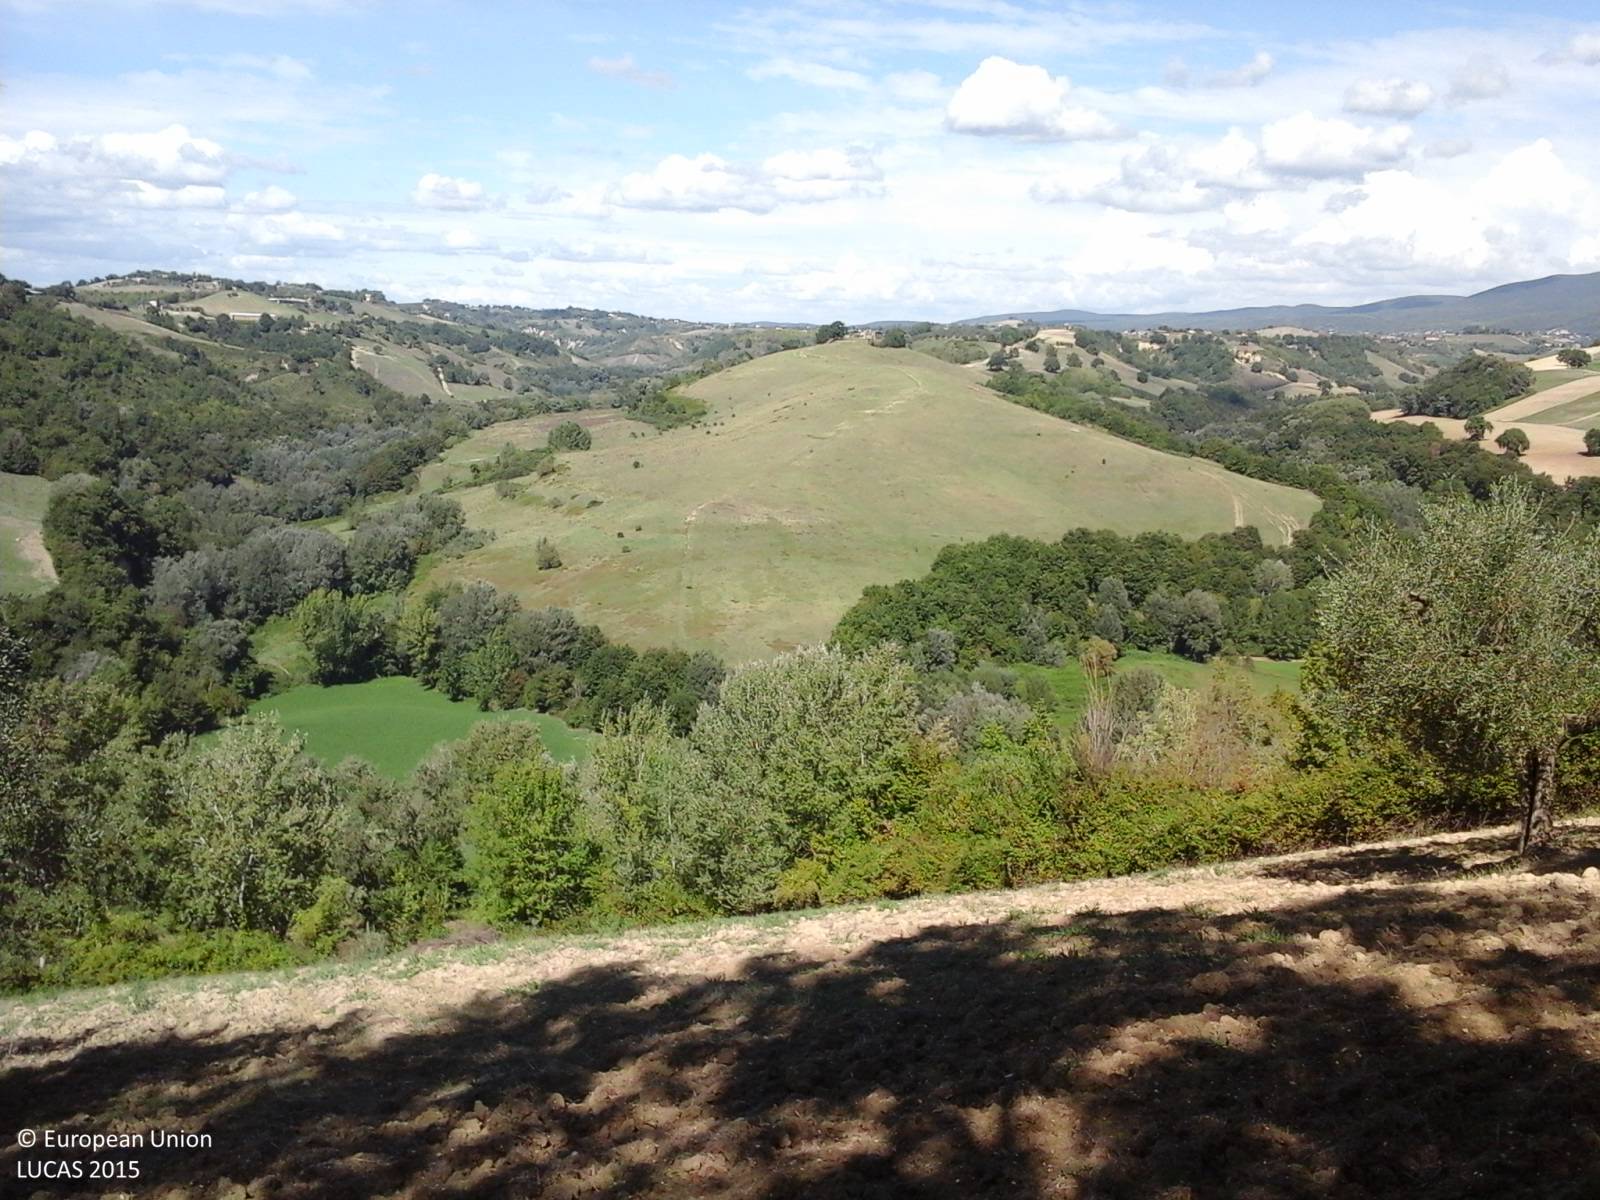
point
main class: Grassland
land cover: Grassland without tree/shrub cover
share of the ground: > 75 %
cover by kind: herbaceous plants 100 %
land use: Agriculture (excluding fallow land and kitchen gardens)
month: September
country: IT
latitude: 42.3514
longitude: 12.5286
